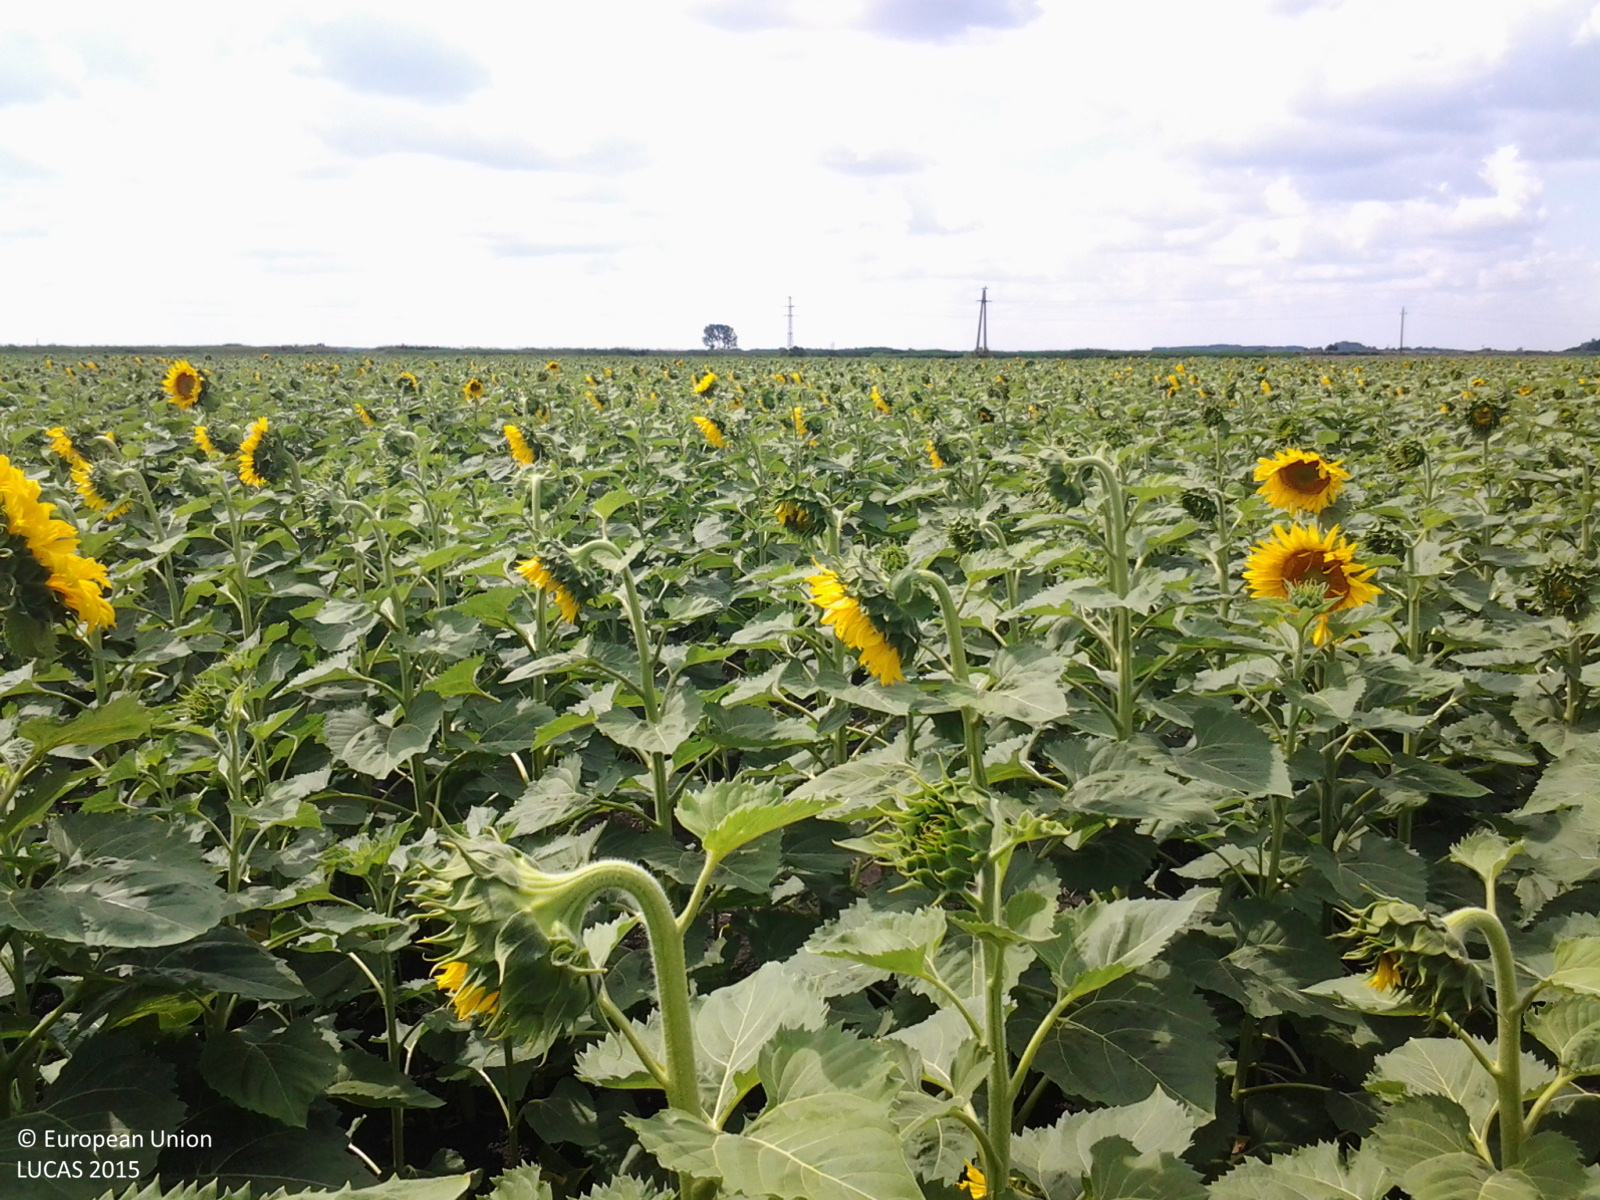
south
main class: Cropland
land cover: Sunflower
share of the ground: > 75 %
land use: Agriculture (excluding fallow land and kitchen gardens)
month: July
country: HU
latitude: 46.9200
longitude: 20.7066
